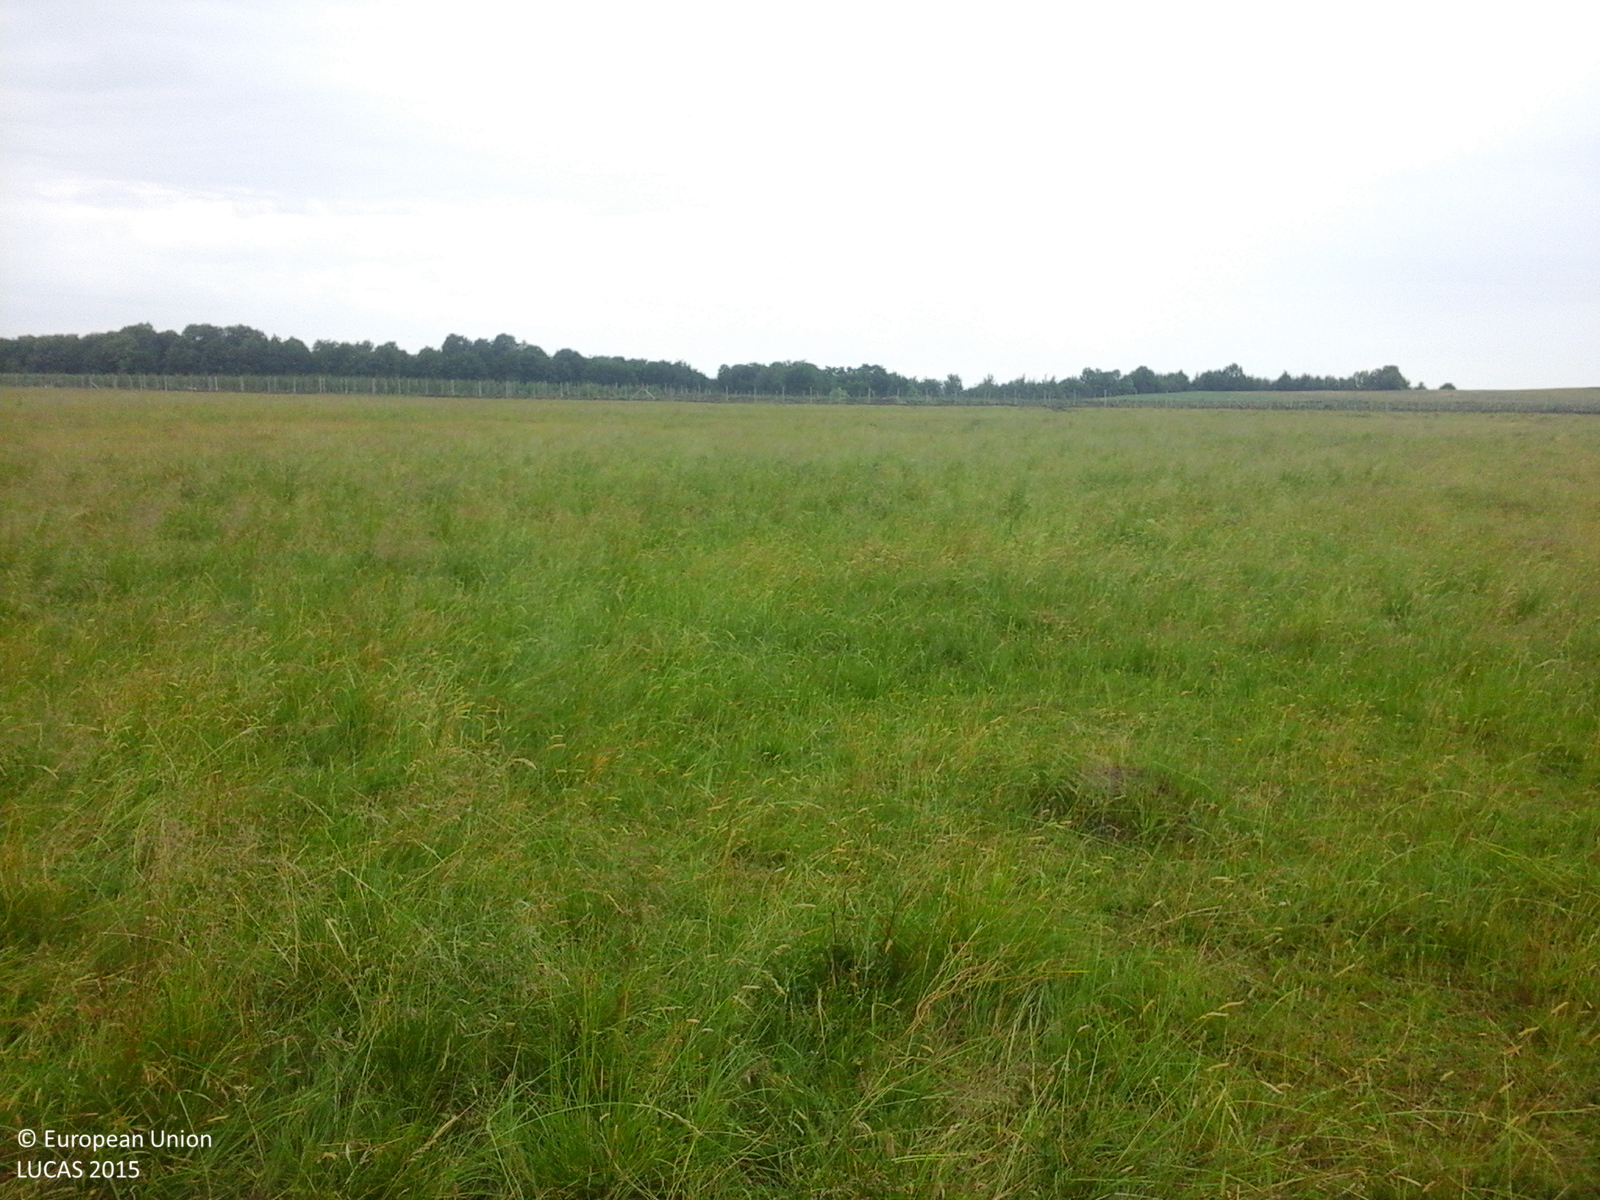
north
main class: Grassland
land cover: Grassland without tree/shrub cover
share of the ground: > 75 %
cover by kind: herbaceous plants 100 %
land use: Agriculture (excluding fallow land and kitchen gardens)
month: June
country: RO
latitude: 47.4907
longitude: 26.2075
